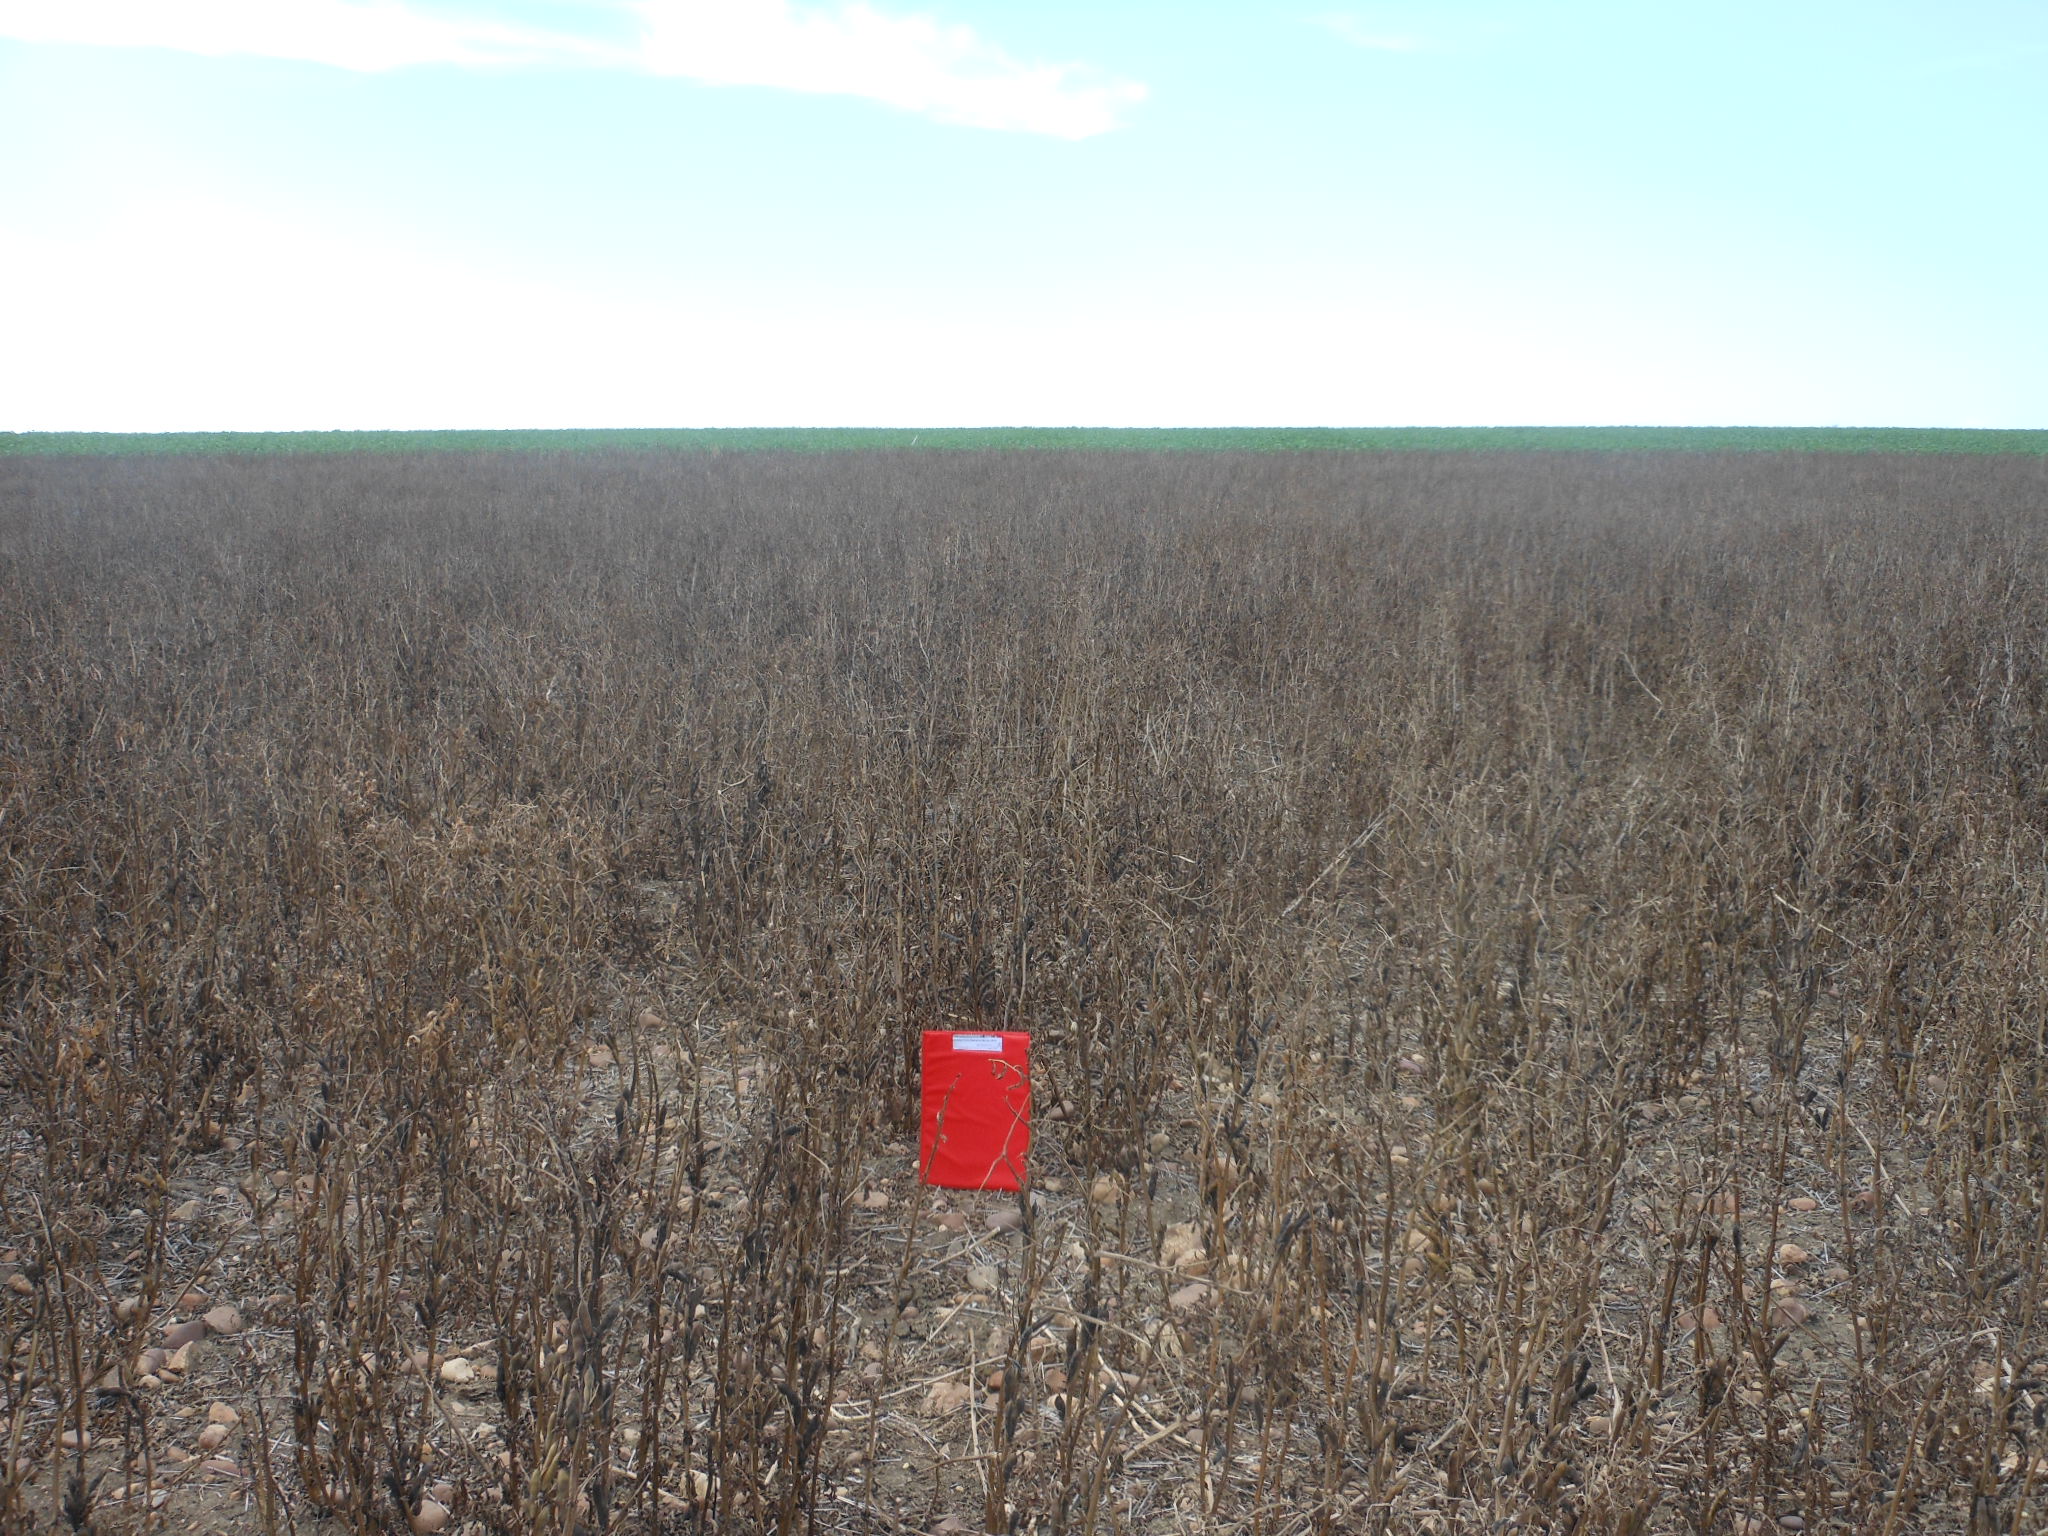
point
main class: Cropland
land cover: Dry pulses
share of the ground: 50 - 75 %
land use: Agriculture (excluding fallow land and kitchen gardens)
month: May
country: ES
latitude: 37.4601
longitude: -5.5174
